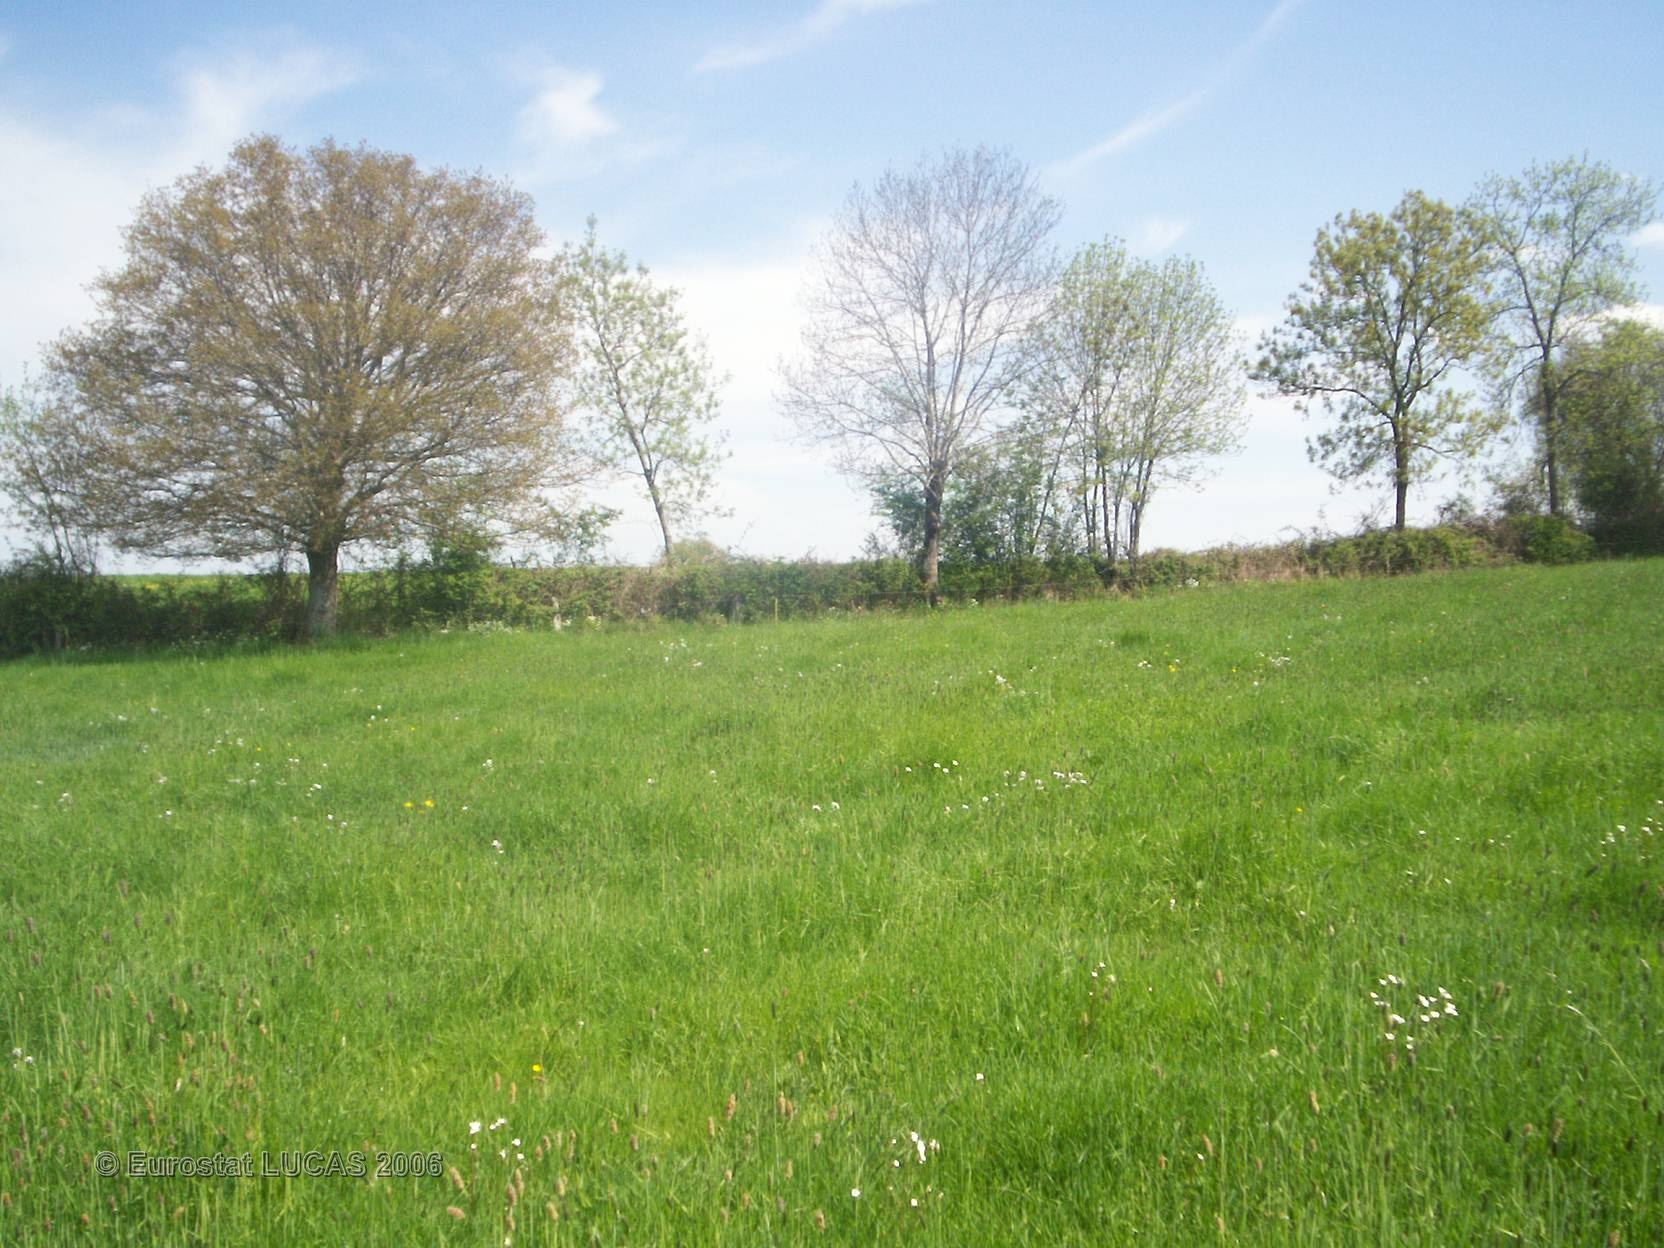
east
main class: Grassland
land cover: Grassland without tree/shrub cover
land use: Agriculture (excluding fallow land and kitchen gardens)
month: May
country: FR
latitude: 46.3400
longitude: 3.0209
